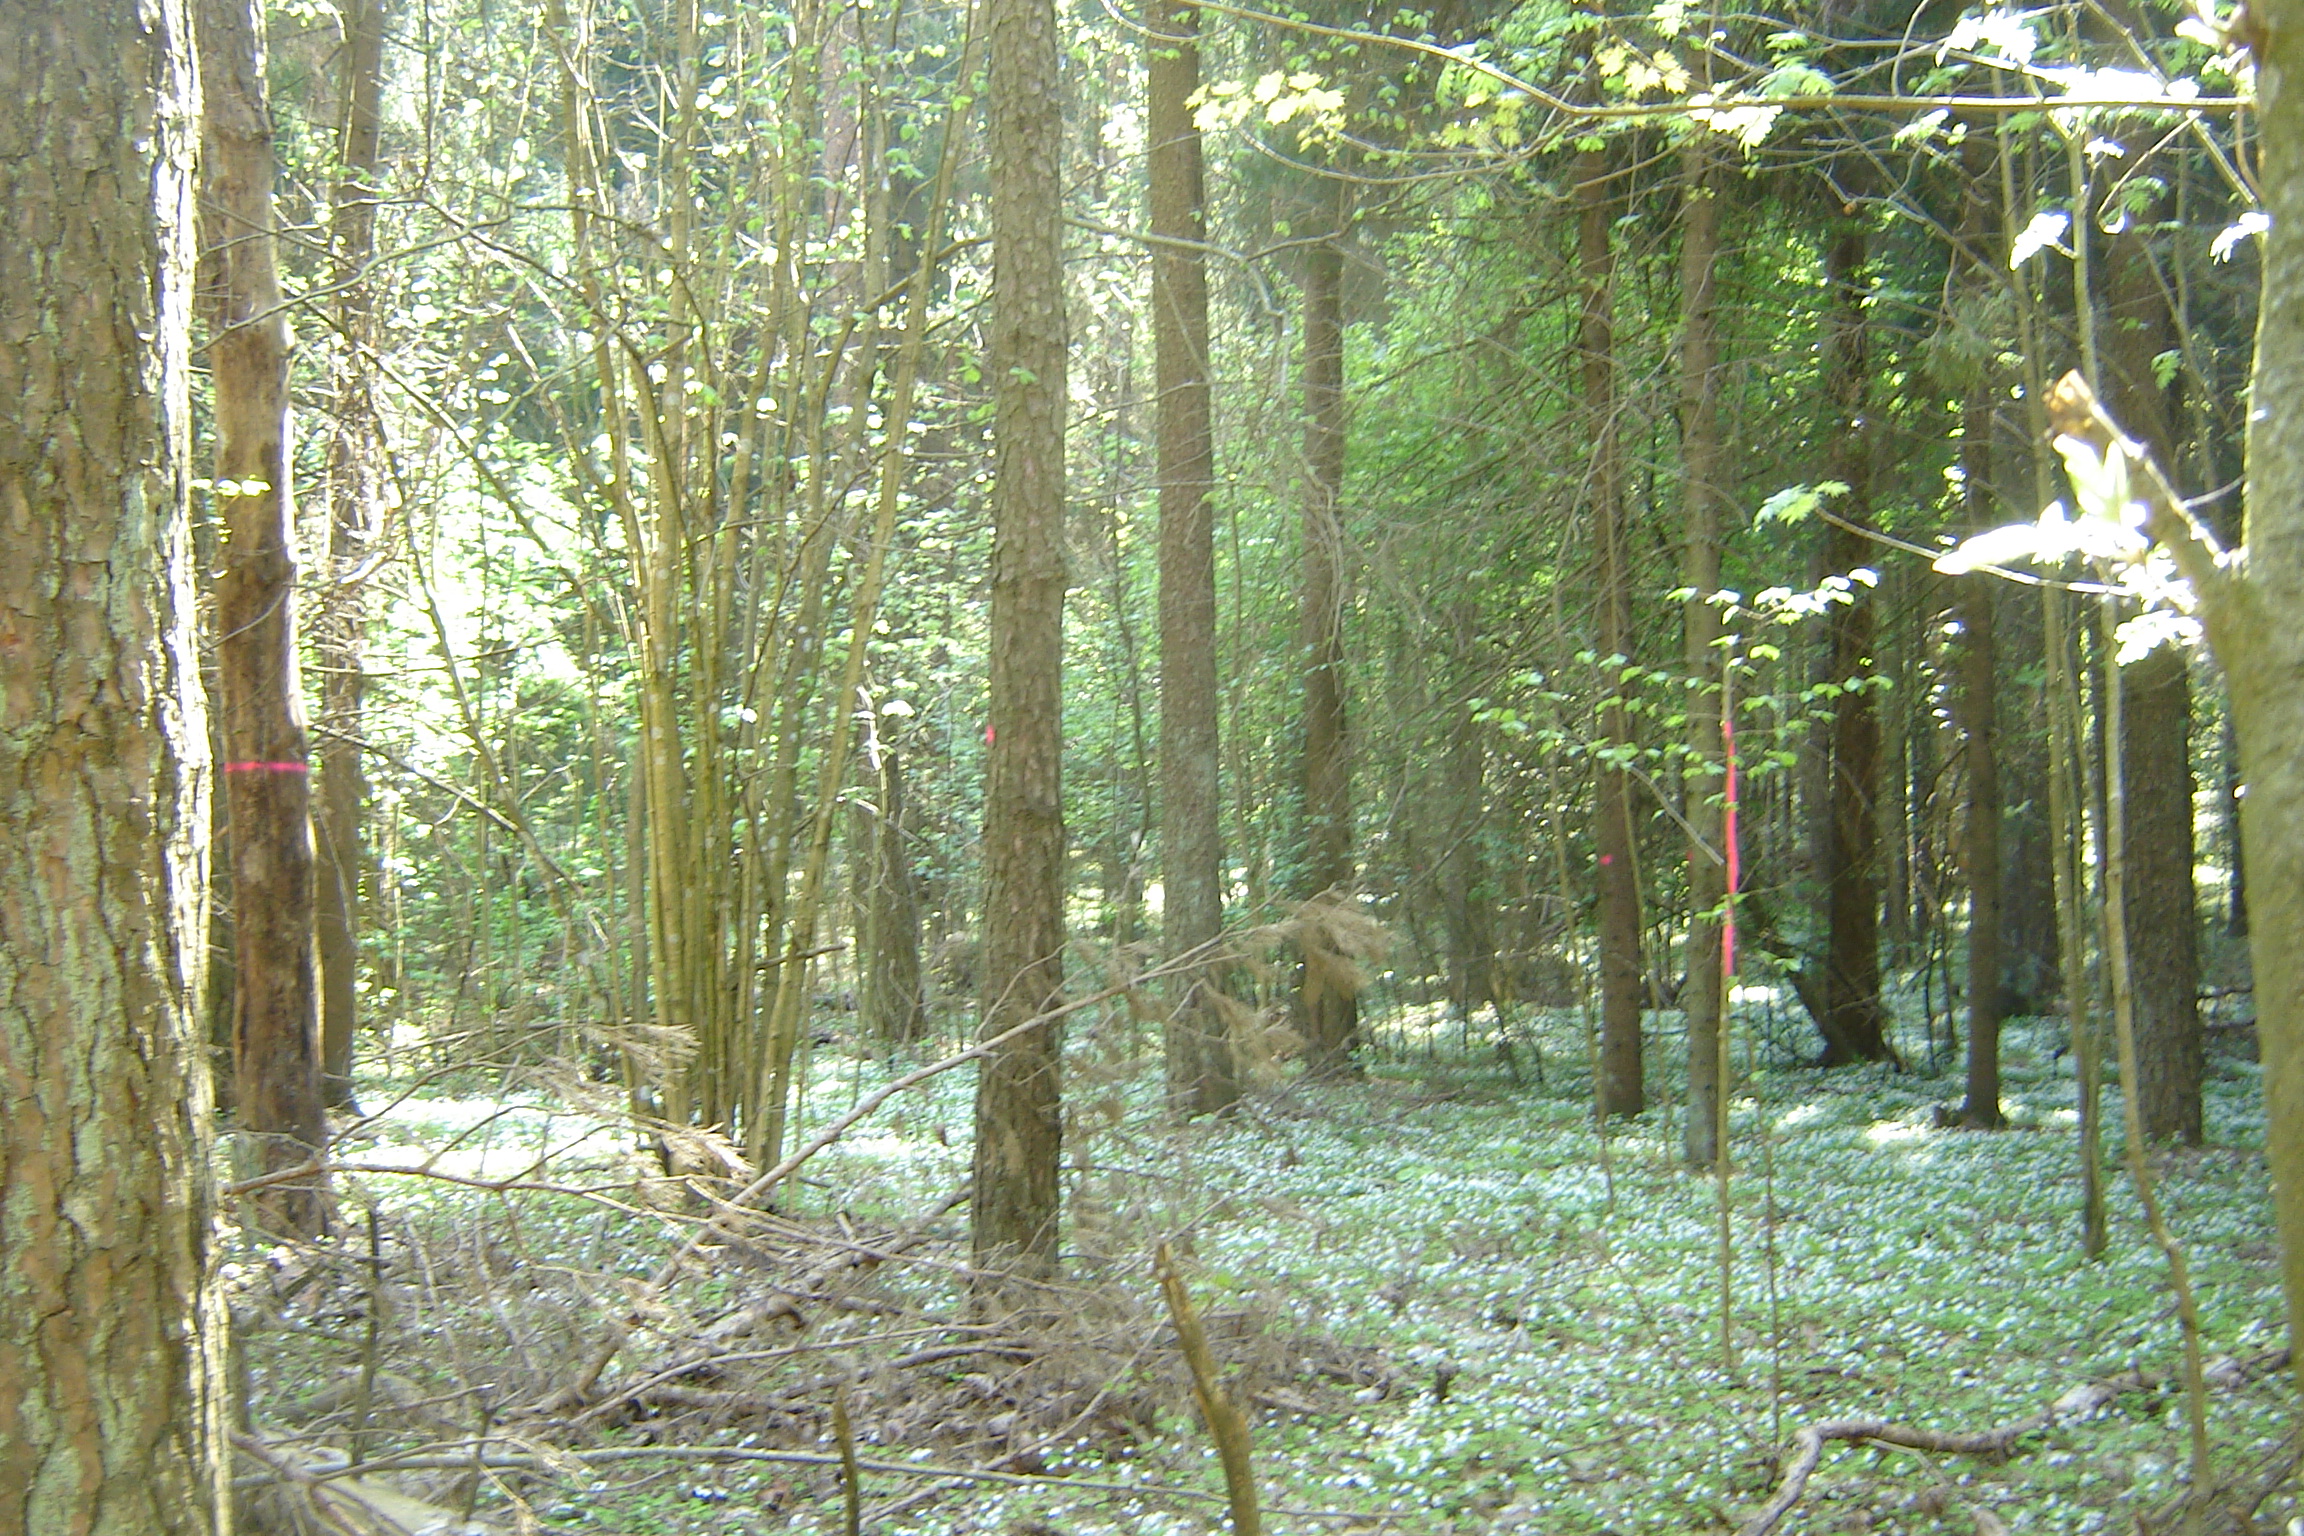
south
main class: Woodland
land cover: Other coniferous woodland
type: hemiboreal forest and nemoral coniferous forest and mixed broadleaved-coniferous forest
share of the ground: > 75 %
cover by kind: coniferous forest trees 100 %
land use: Forestry
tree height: > 5 m
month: May
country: LT
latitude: 56.0195
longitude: 25.7053
